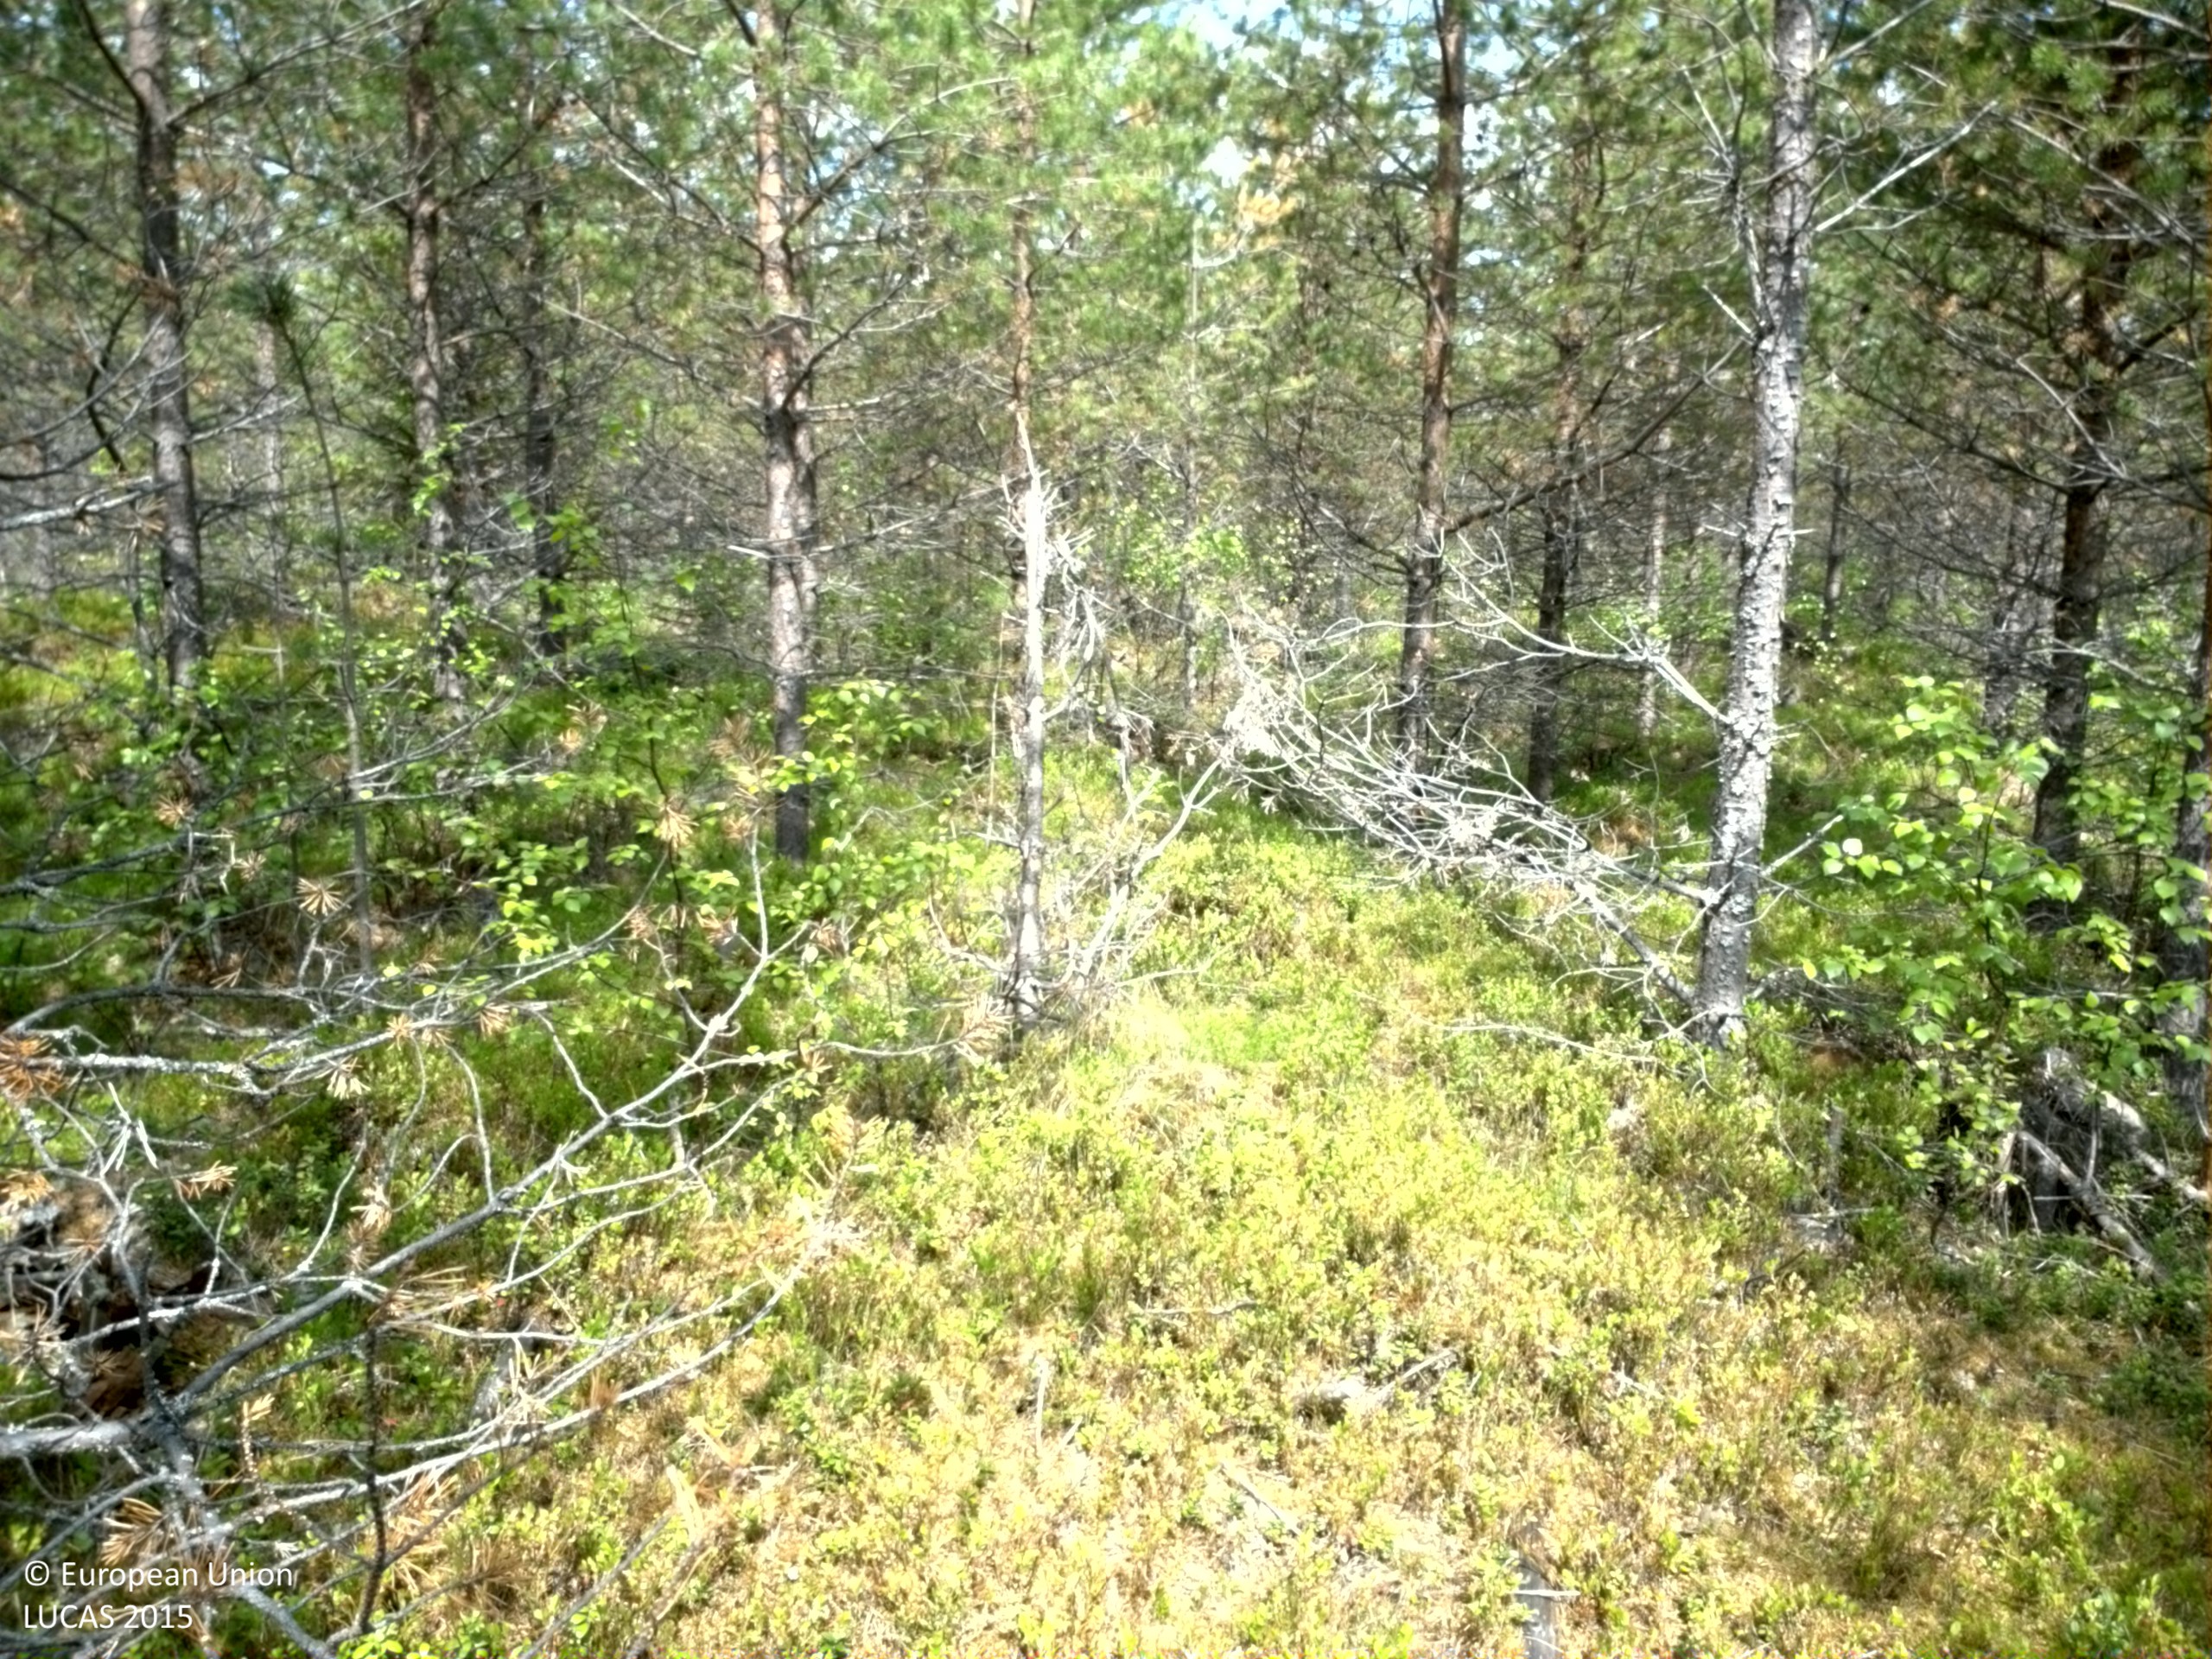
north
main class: Woodland
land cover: Pine dominated coniferous woodland
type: boreal forest
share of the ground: > 75 %
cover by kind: coniferous forest trees 85 %, shrubs 15 %
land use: Forestry
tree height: > 5 m
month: June
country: SE
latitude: 62.9757
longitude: 16.9799
